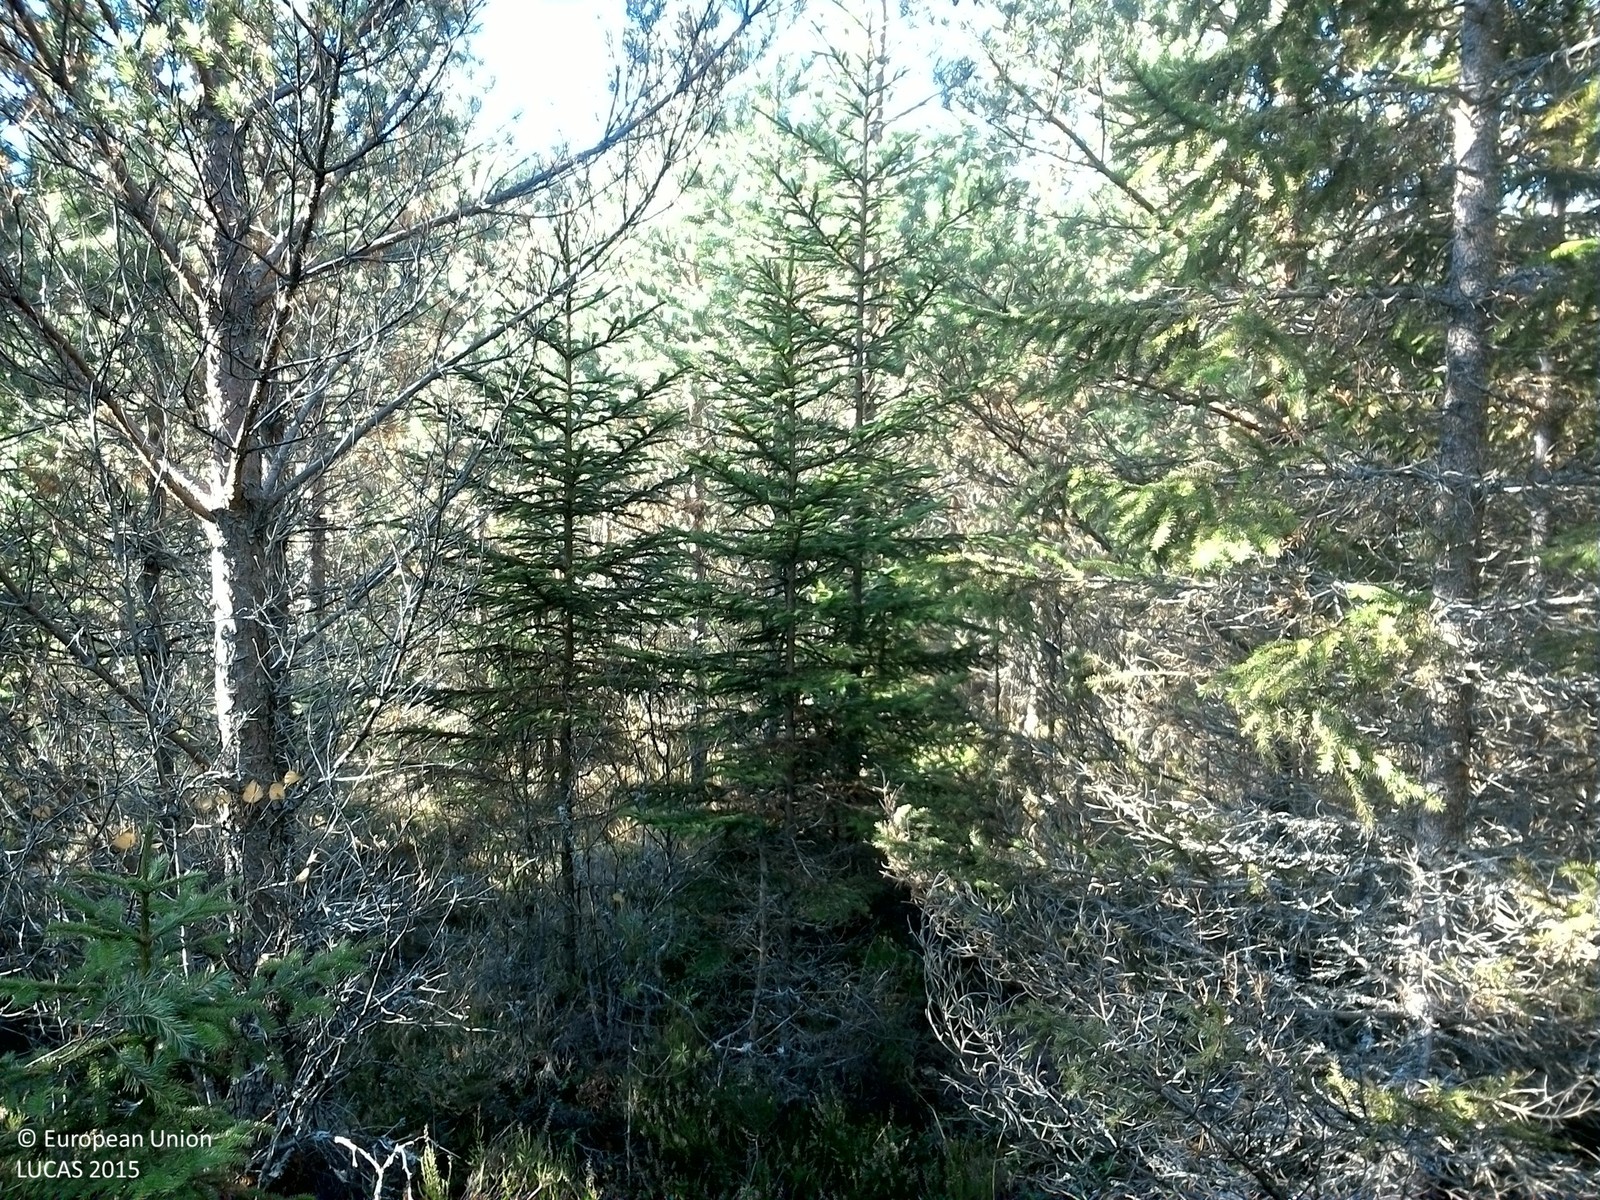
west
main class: Woodland
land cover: Other coniferous woodland
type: boreal forest
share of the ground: > 75 %
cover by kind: coniferous forest trees 75 %, shrubs 15 %, broadleaved forest trees 5 %, lichens and mosses 5 %
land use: Forestry
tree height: > 5 m
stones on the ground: < 10 %
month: October
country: SE
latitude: 59.4575
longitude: 15.0896
